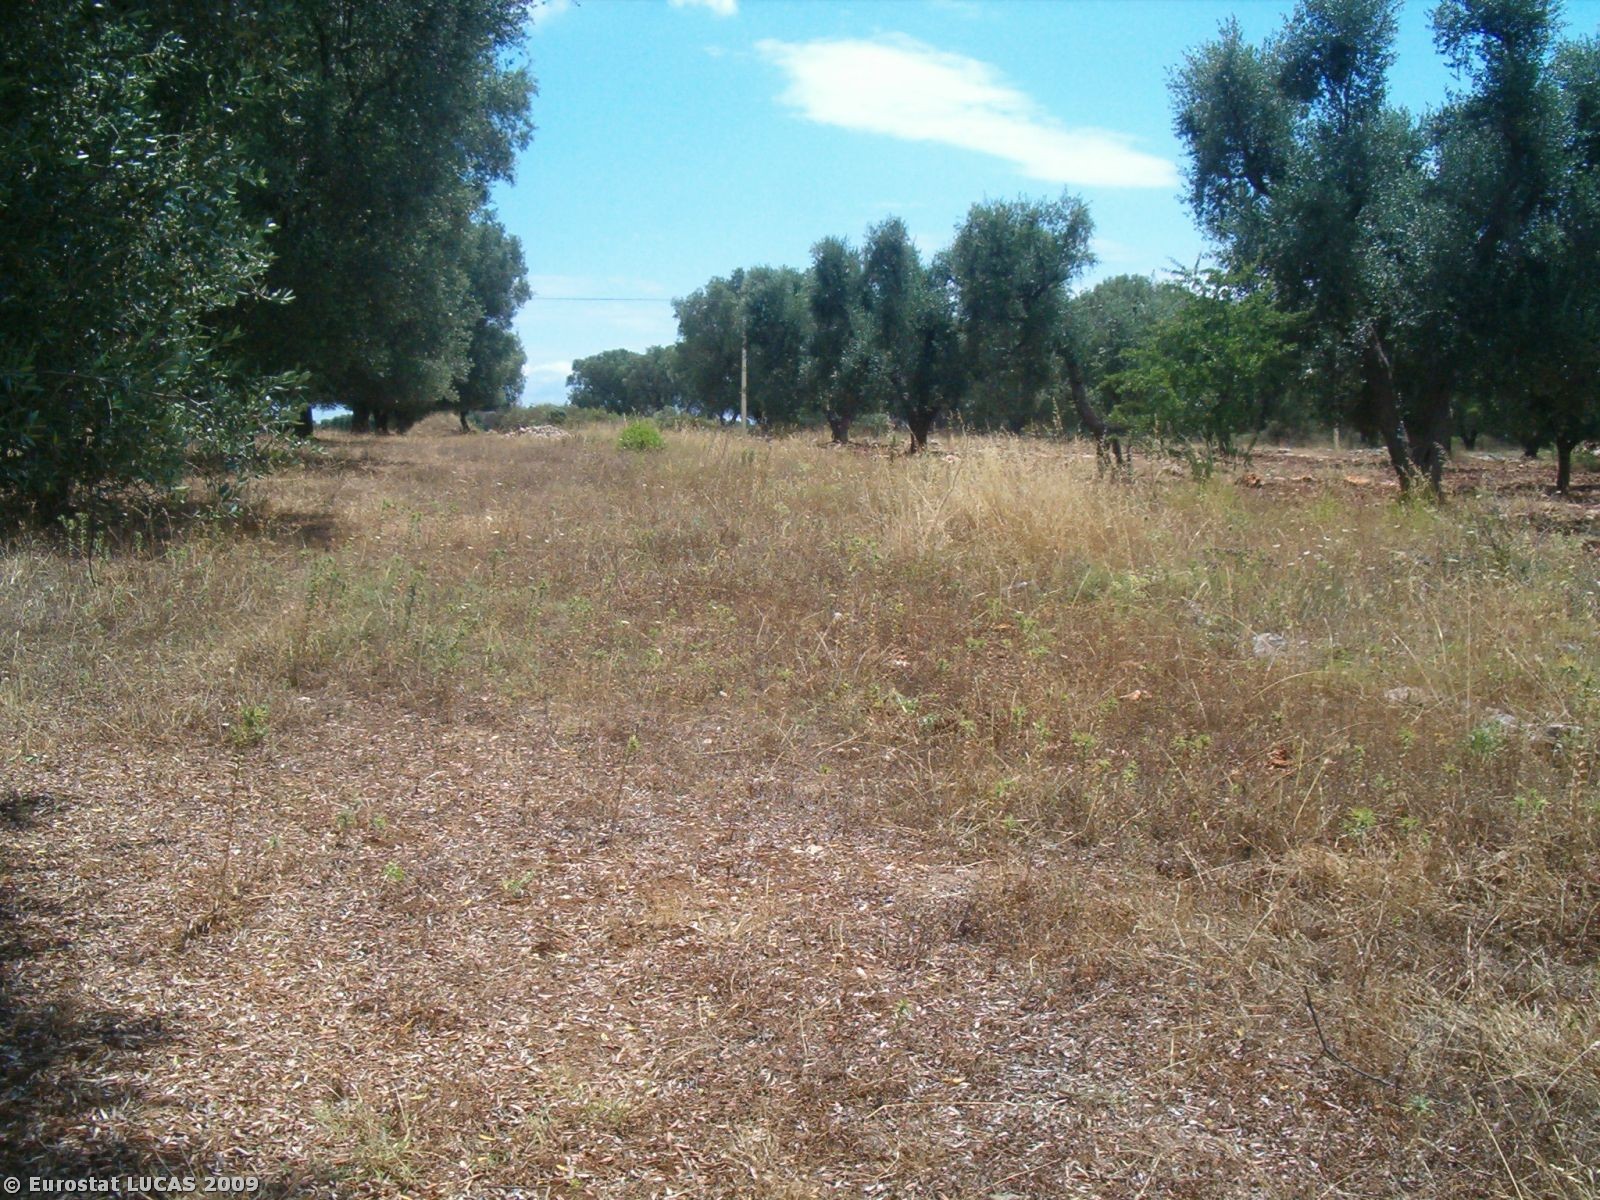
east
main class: Cropland
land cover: Olive groves
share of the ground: 50 - 75 %
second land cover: Spontaneously vegetated surfaces
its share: > 75 %
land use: Agriculture (excluding fallow land and kitchen gardens)
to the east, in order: Olive groves; Spontaneously vegetated surfaces; Electric lines; Olive groves; Spontaneously vegetated surfaces; Tracks; Olive groves; Spontaneously vegetated surfaces; Dry stone walls; Grass margins; Paved roads, cycling and walking lanes; Grass margins; Olive groves; Spontaneously vegetated surfaces; Dry stone walls; Fences; Grass margins; Tracks; Spontaneously vegetated surfaces
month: June
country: IT
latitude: 40.5037
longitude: 17.5399
